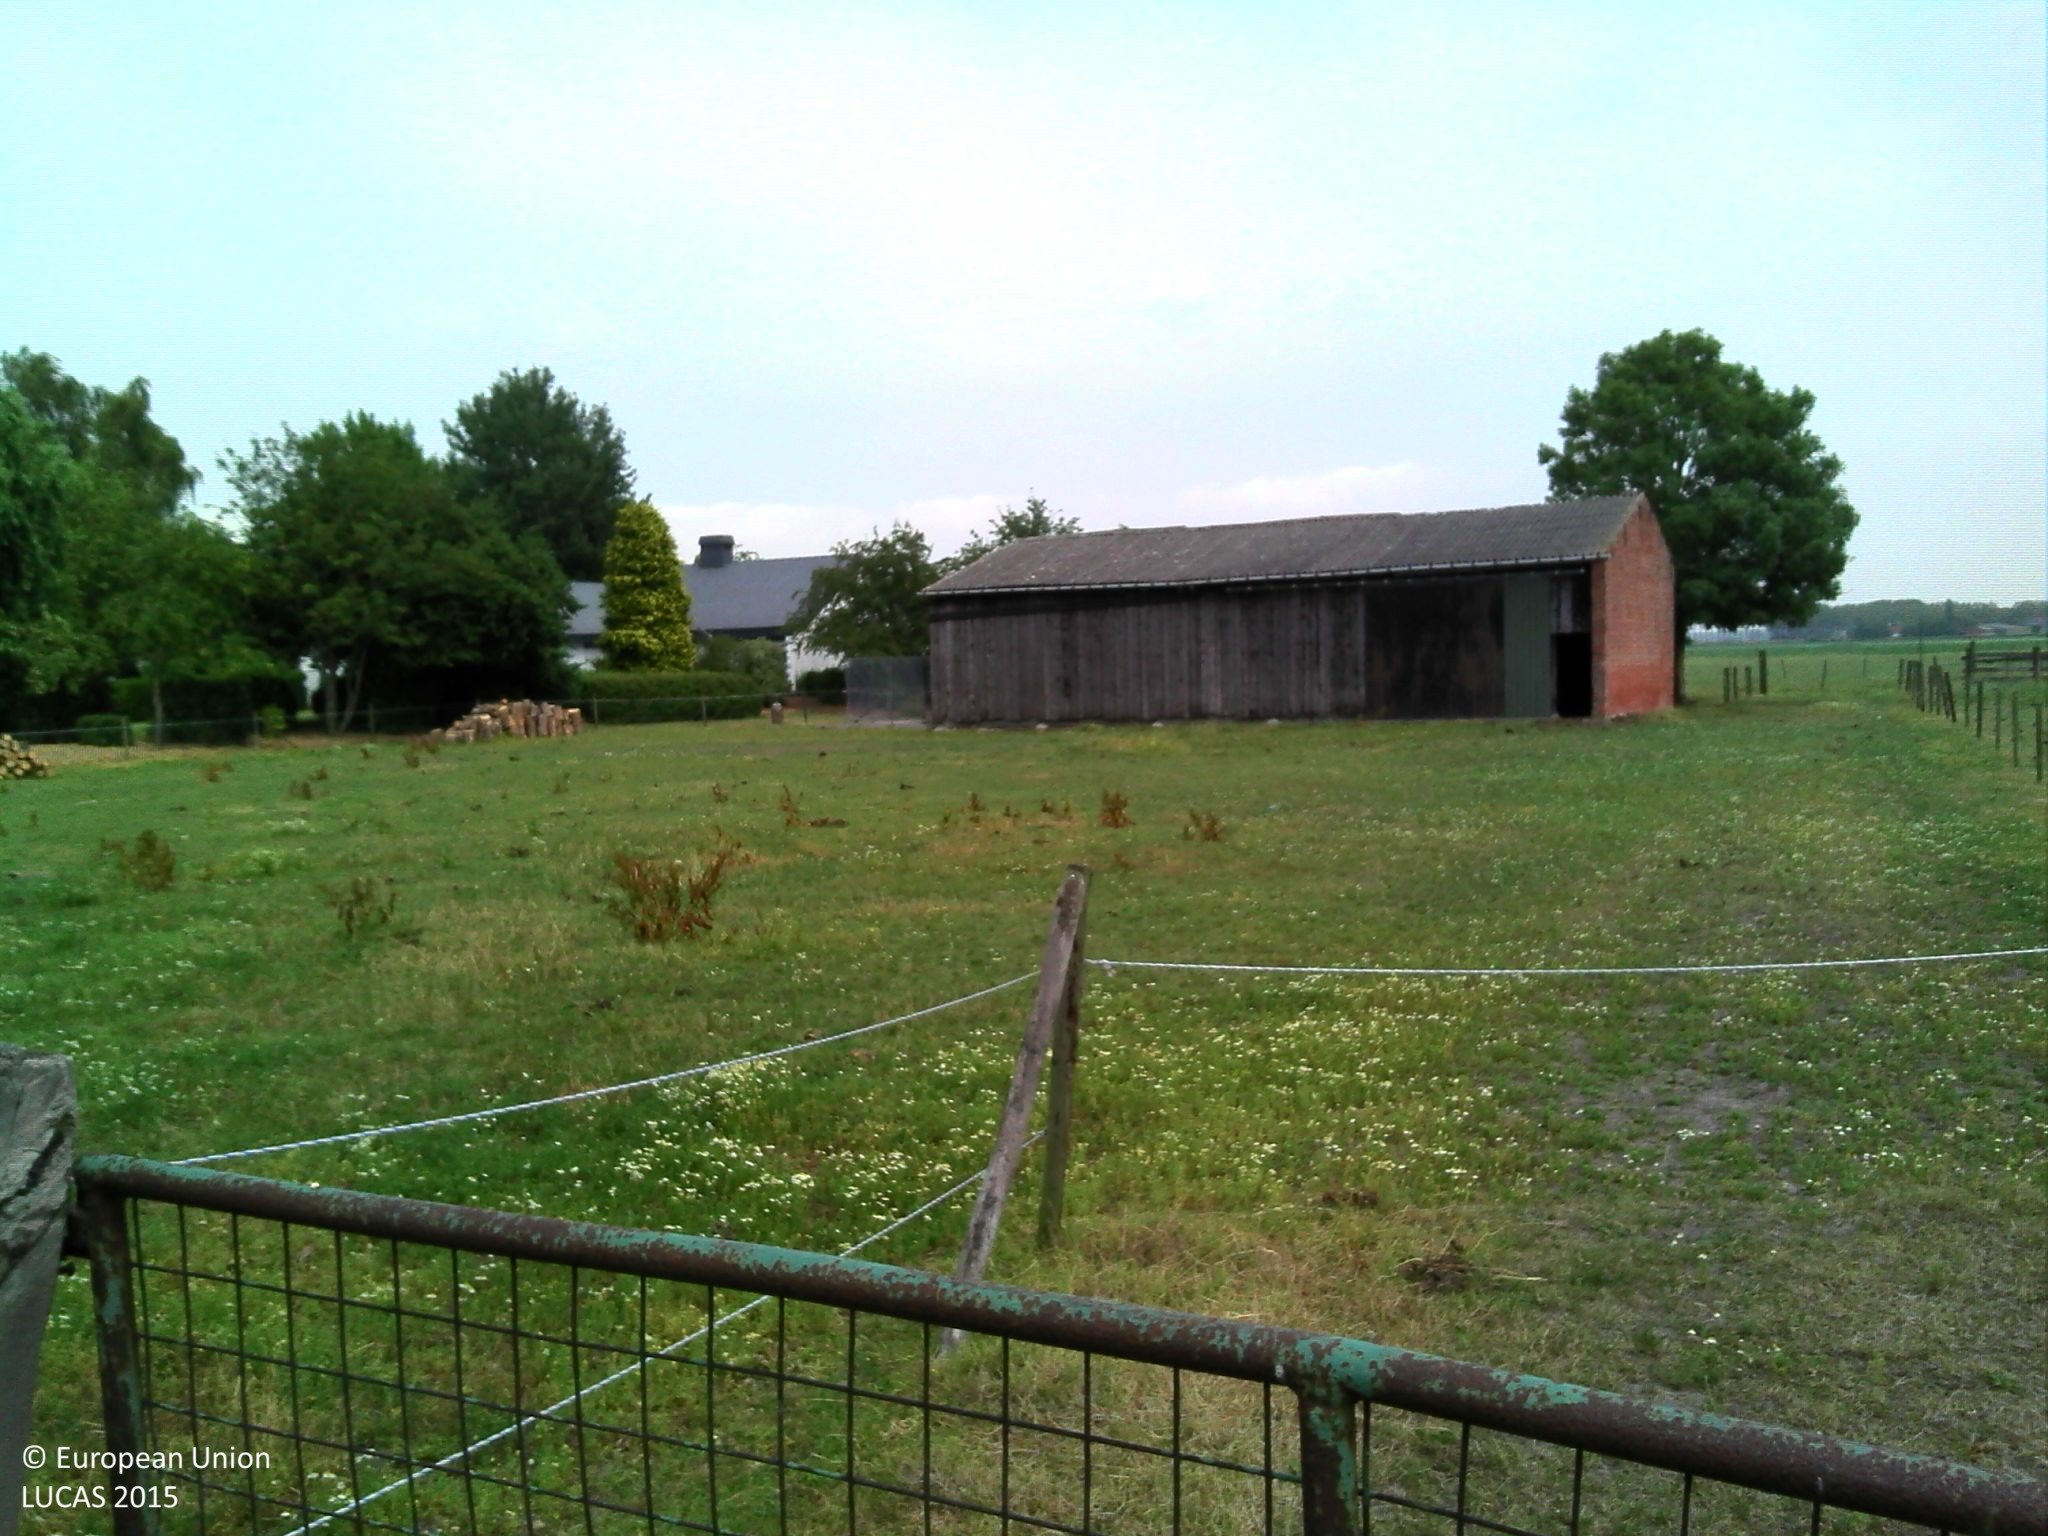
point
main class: Grassland
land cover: Grassland without tree/shrub cover
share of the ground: > 75 %
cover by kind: herbaceous plants 100 %
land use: Agriculture (excluding fallow land and kitchen gardens)
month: July
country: BE
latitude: 51.2873
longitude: 3.6407
